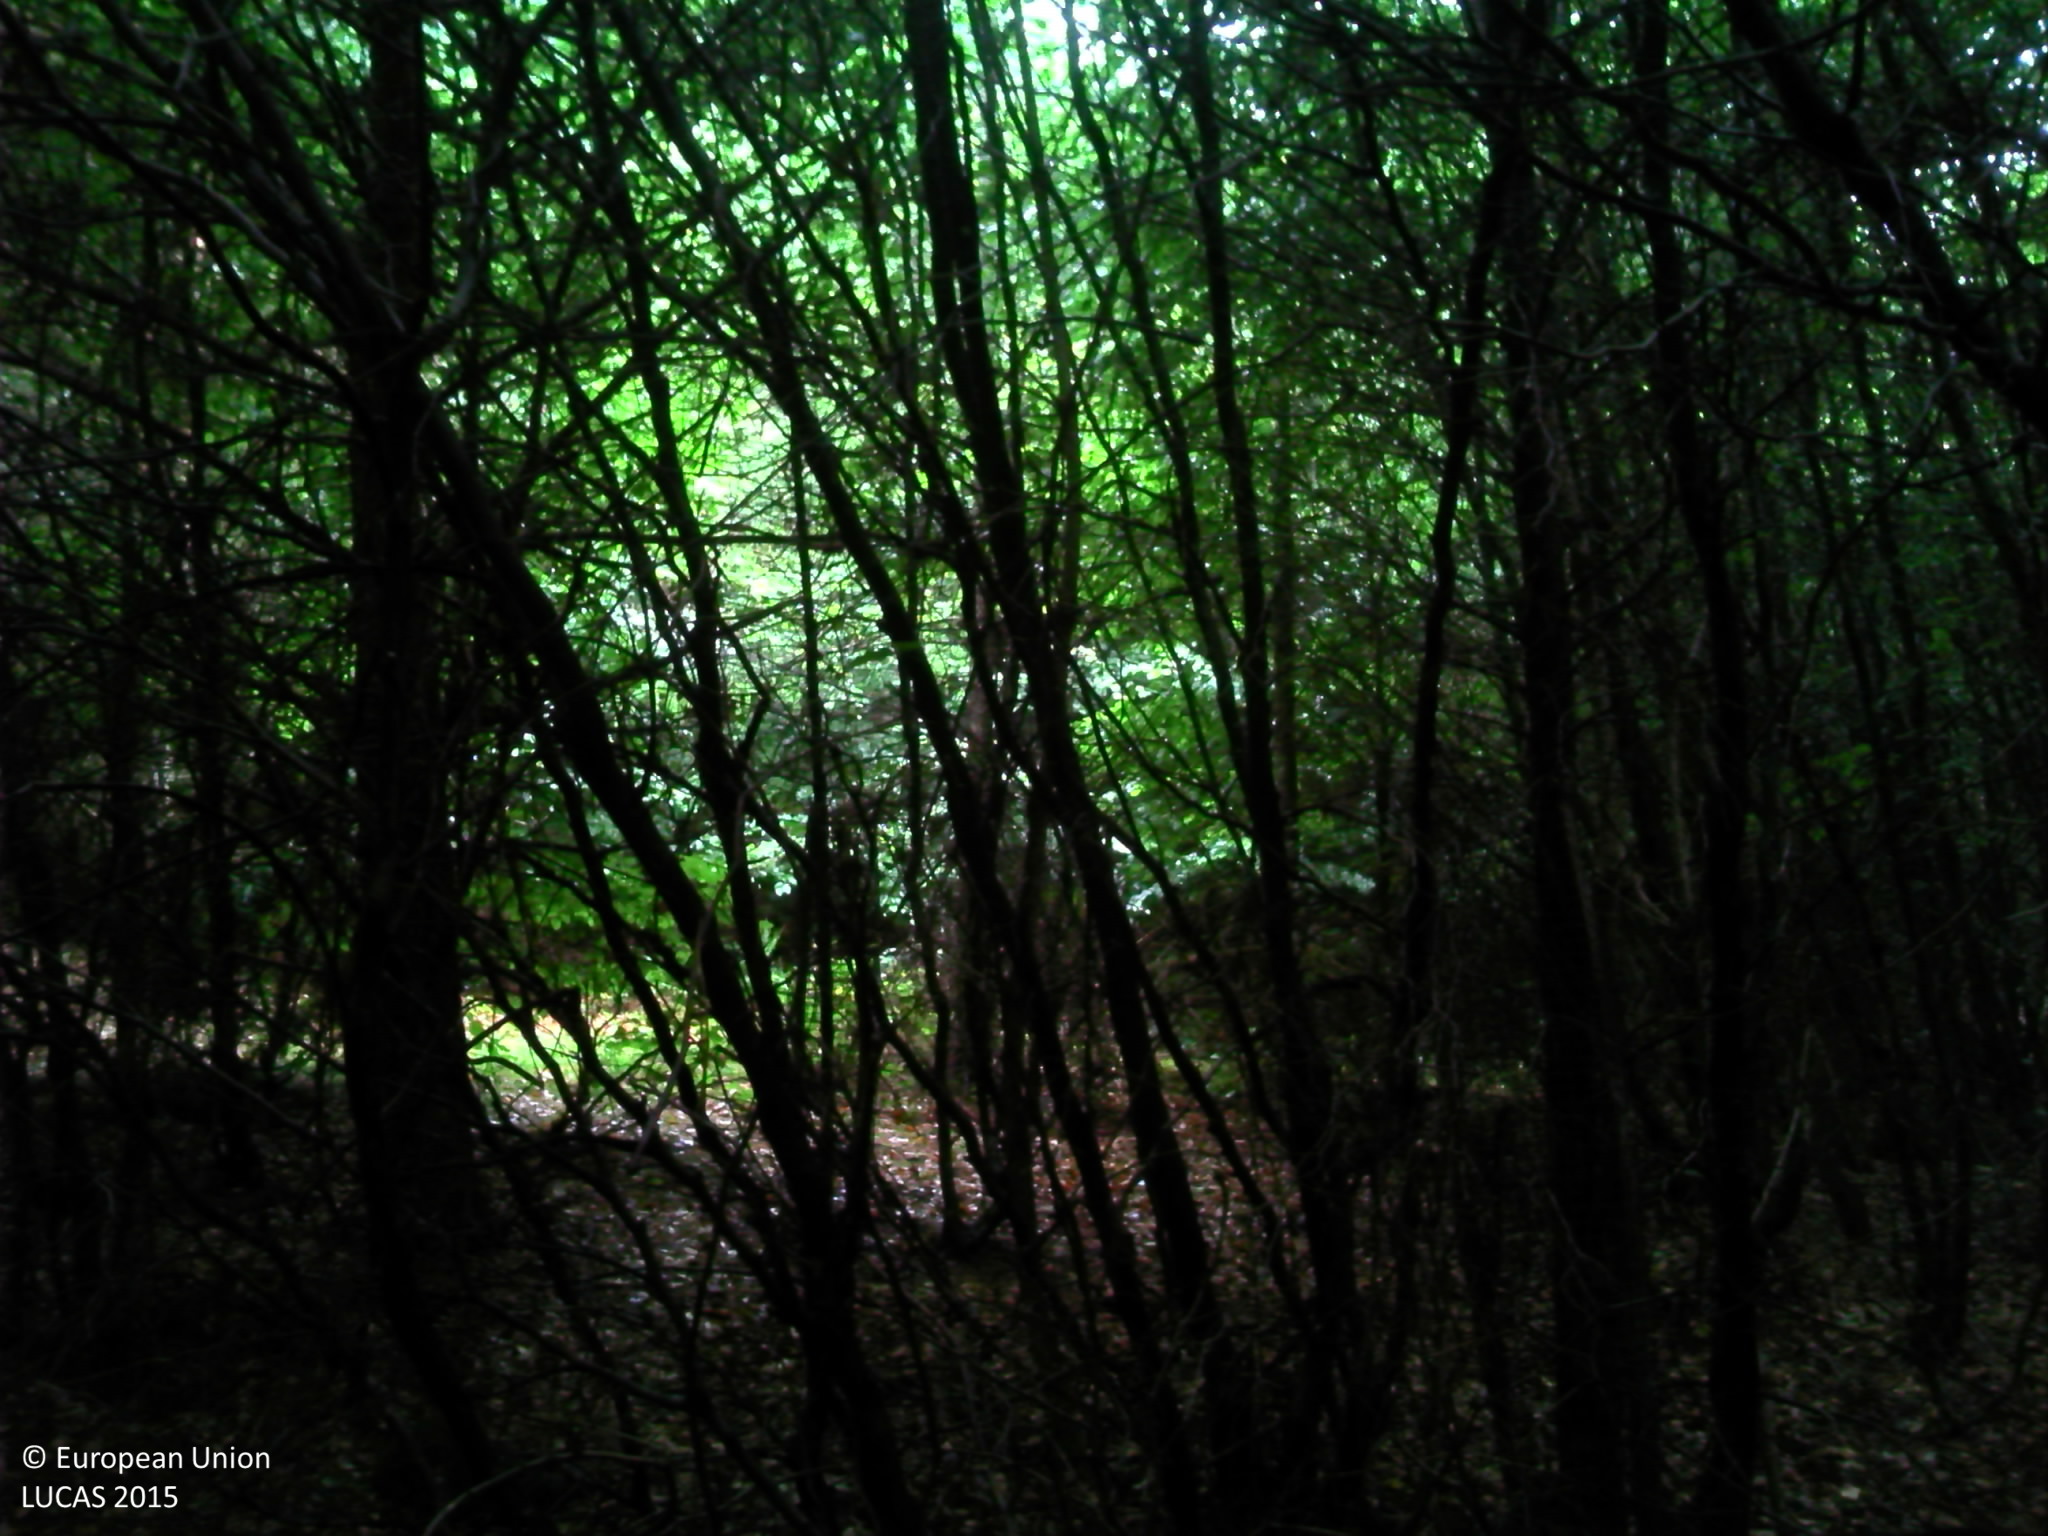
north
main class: Woodland
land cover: Broadleaved woodland
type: beech forest
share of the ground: > 75 %
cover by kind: broadleaved forest trees 100 %
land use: Forestry
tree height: > 5 m
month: July
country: FR
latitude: 48.9711
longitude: 7.5826
